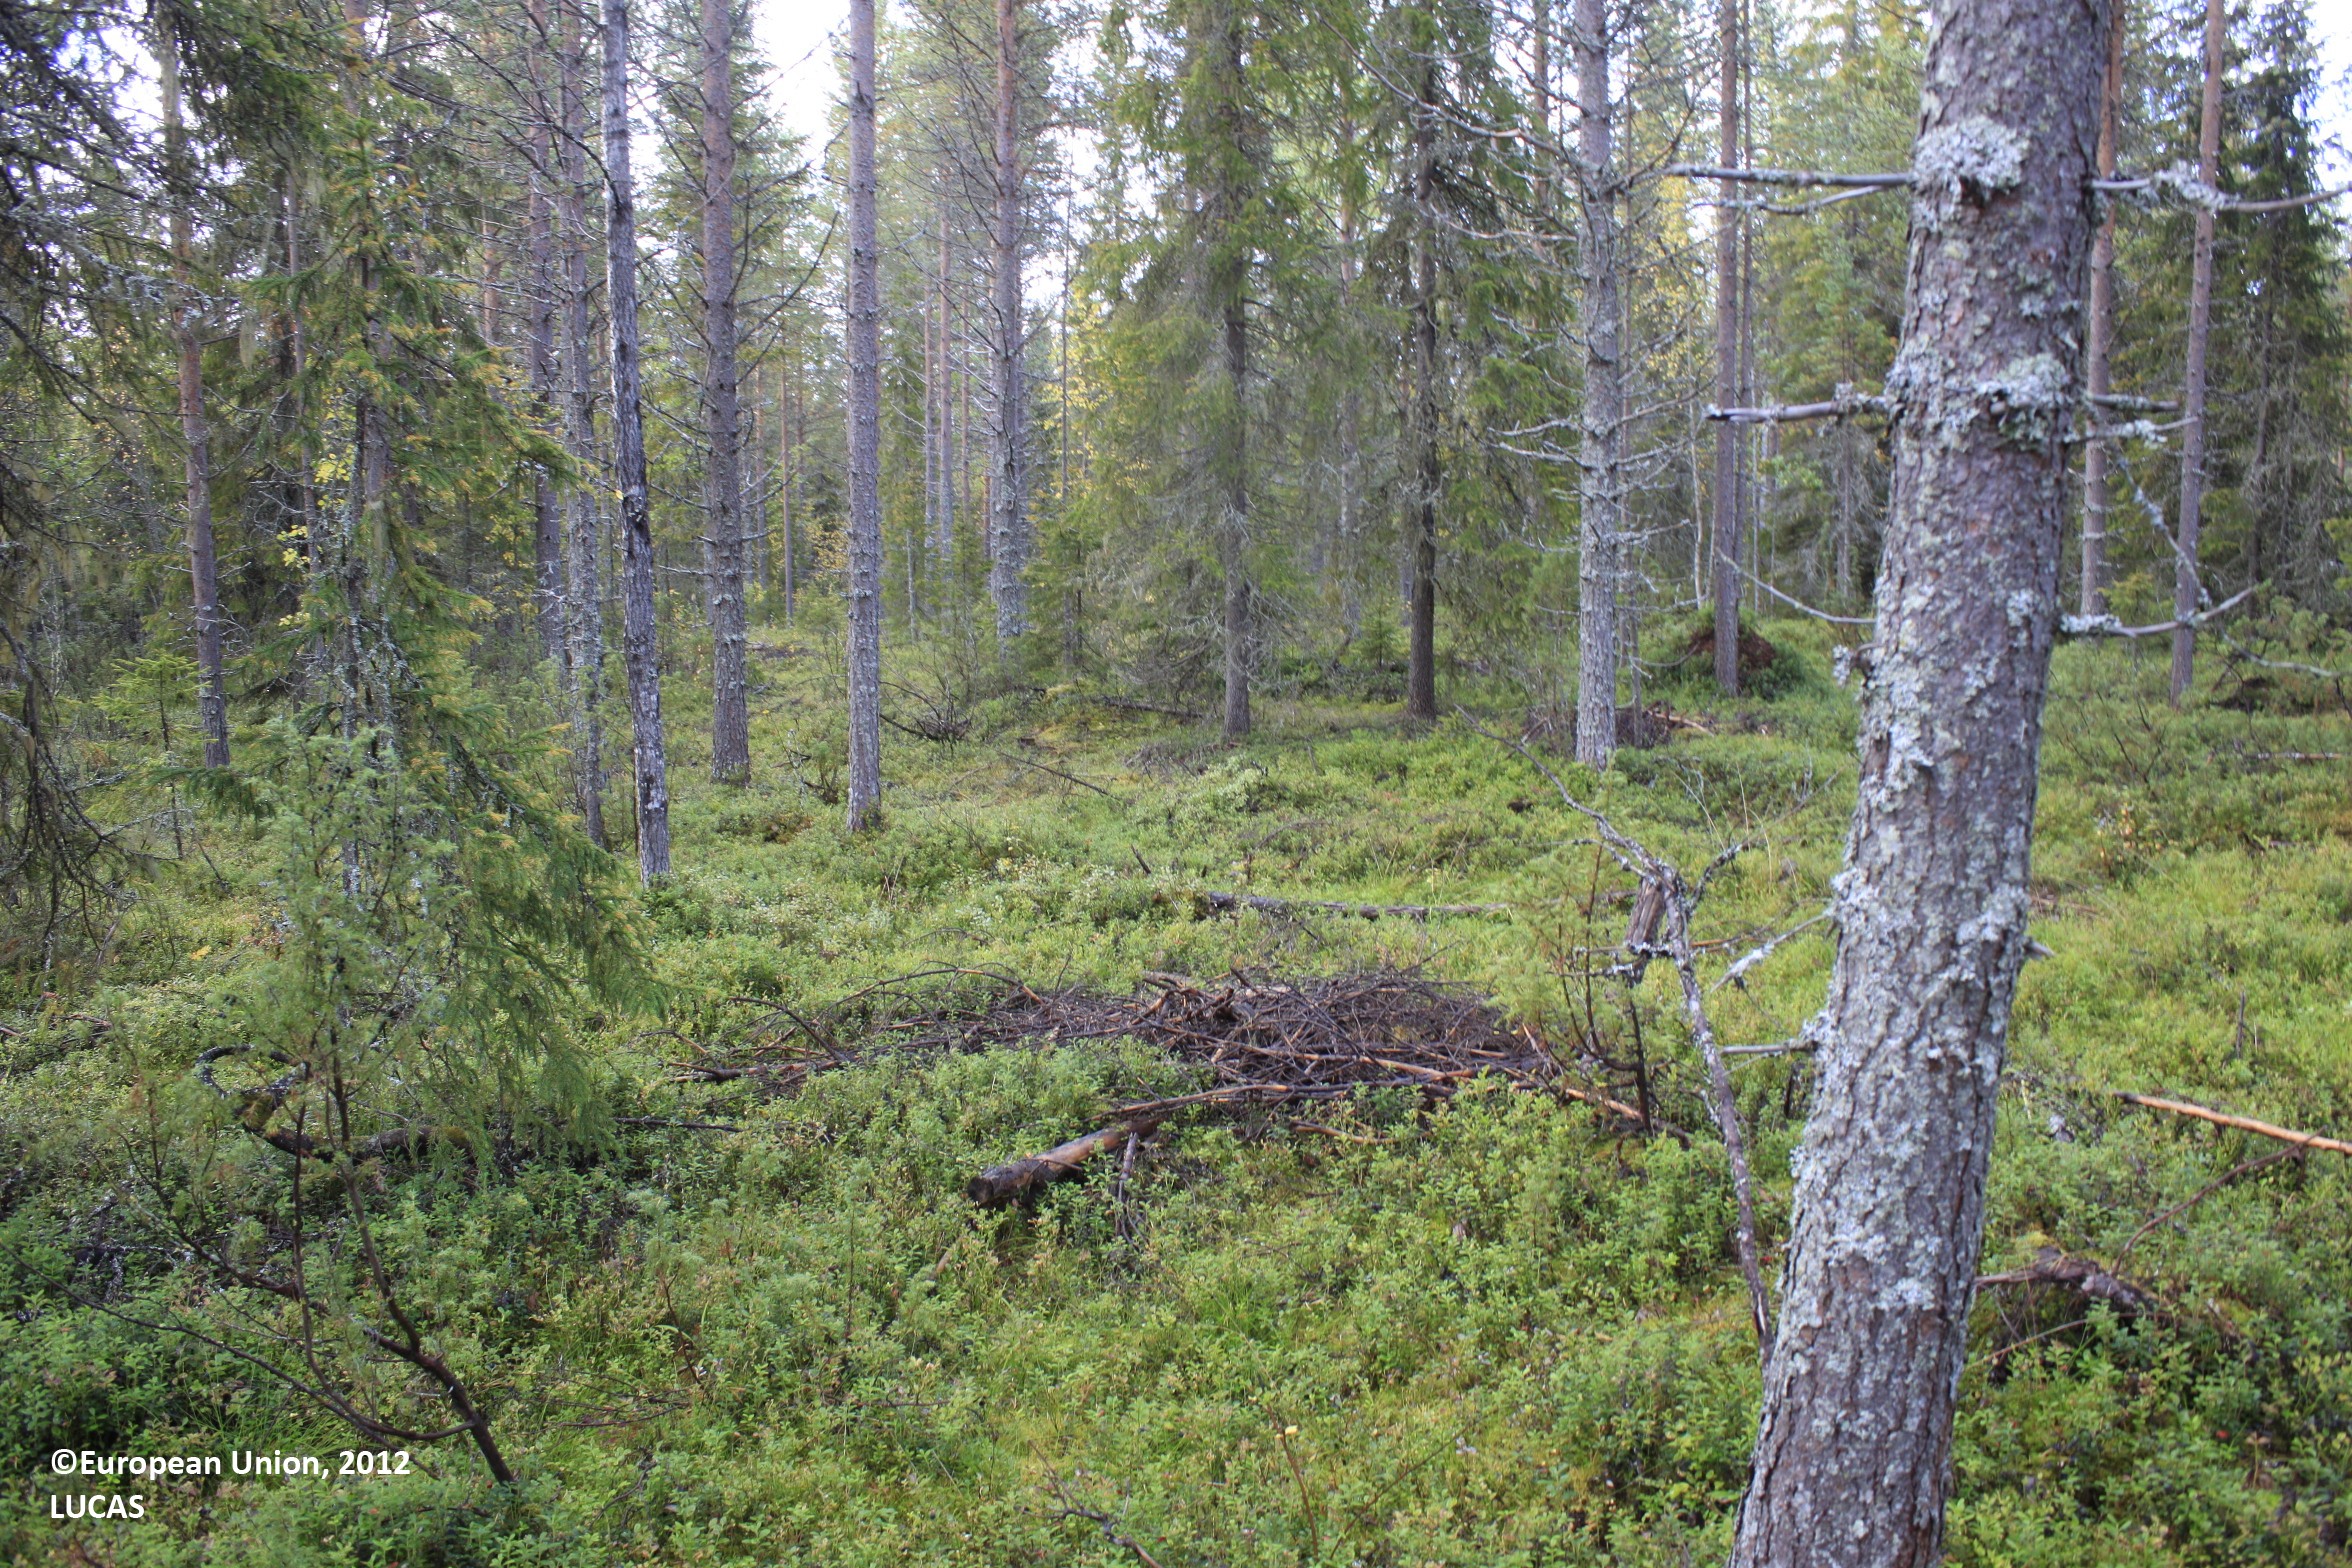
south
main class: Woodland
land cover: Pine dominated mixed woodland
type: boreal forest
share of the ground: 25 - 50 %
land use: Forestry
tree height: > 5 m
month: September
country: FI
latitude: 65.6367
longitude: 26.7249
